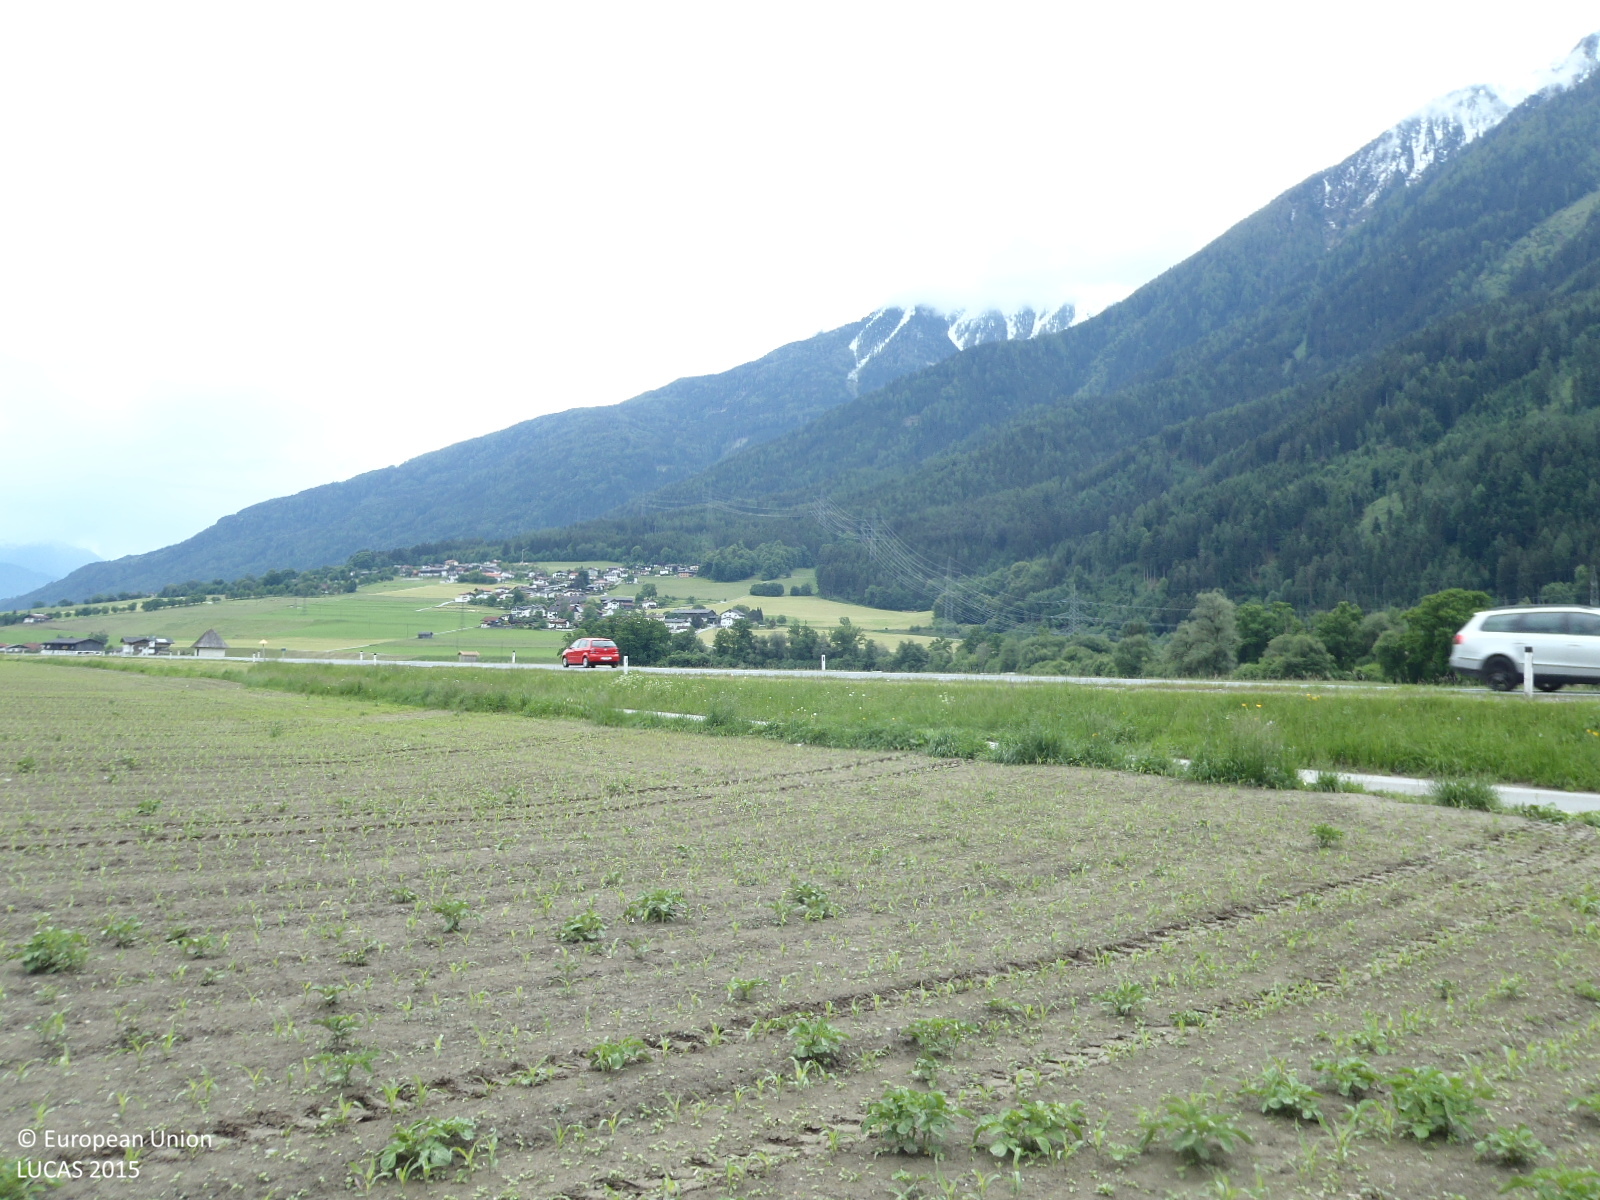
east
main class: Cropland
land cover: Maize
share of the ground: < 10 %
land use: Agriculture (excluding fallow land and kitchen gardens)
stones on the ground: < 10 %
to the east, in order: Maize; Grass margins; Paved roads, cycling and walking lanes; Grass margins; Paved roads, cycling and walking lanes; Grassland without tree/shrub cover; Maize
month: May
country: AT
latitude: 47.2831
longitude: 10.9907
